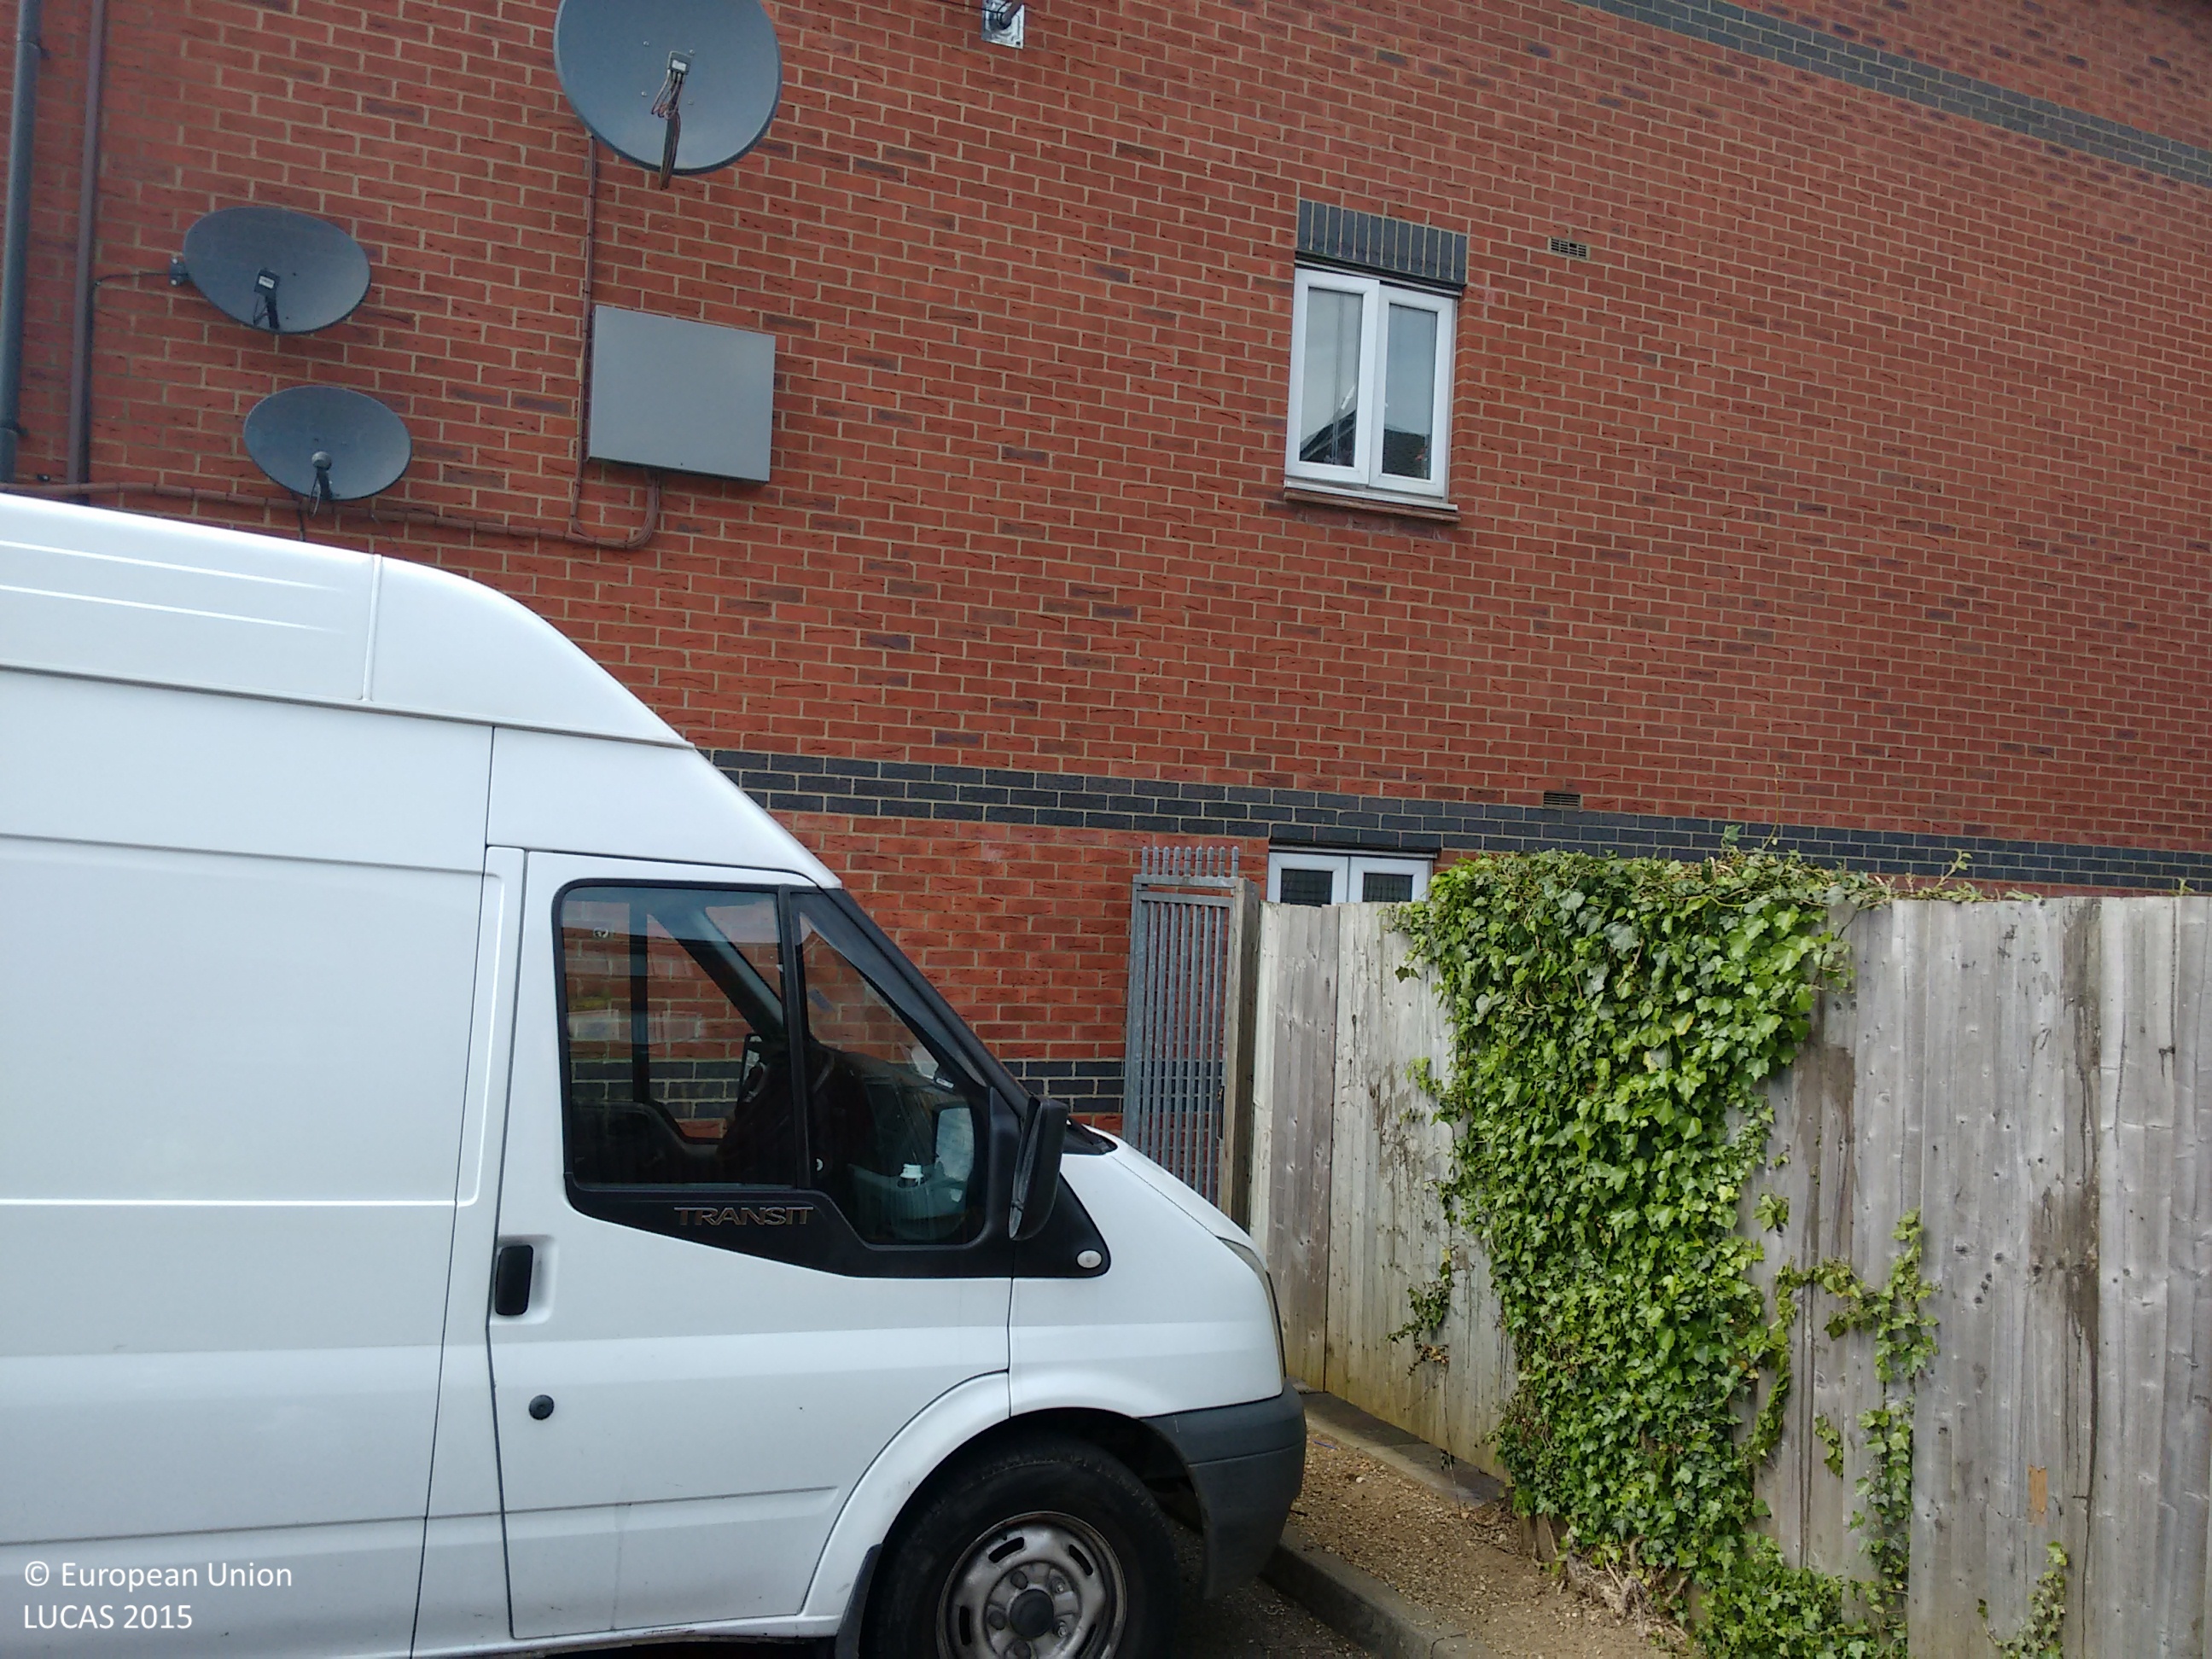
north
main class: Grassland
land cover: Grassland without tree/shrub cover
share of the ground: > 75 %
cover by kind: herbaceous plants 80 %, consolidated bare surface 20 %
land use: Residential
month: May
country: GB
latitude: 51.8810
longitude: -0.4244
